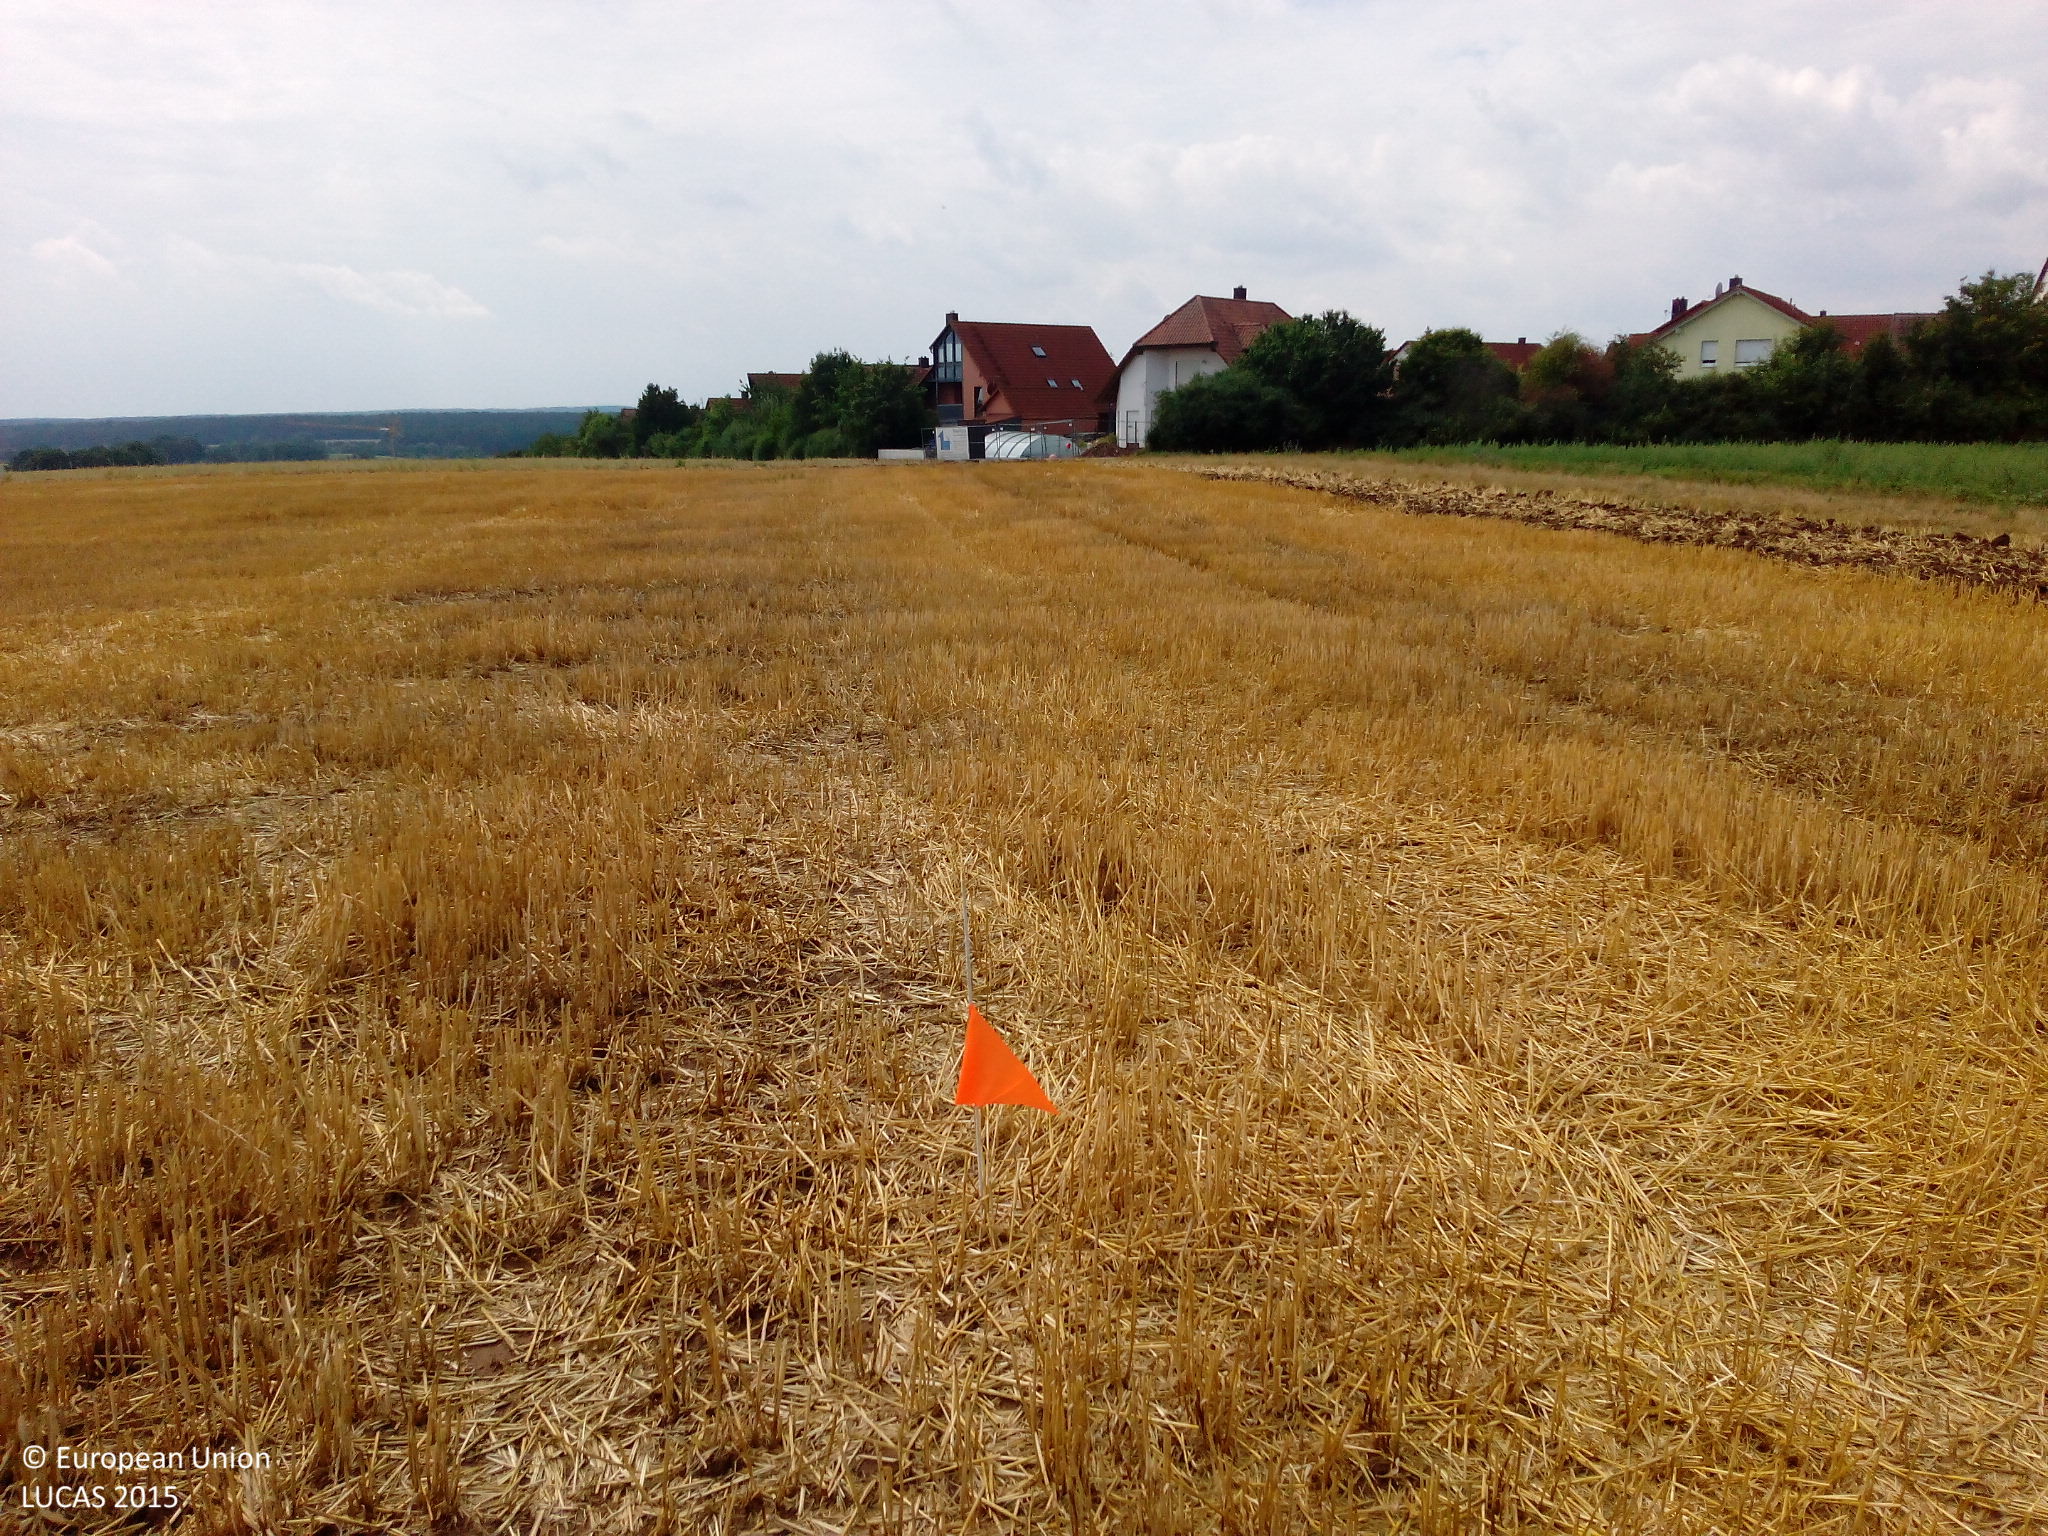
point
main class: Cropland
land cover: Barley
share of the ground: 25 - 50 %
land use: Agriculture (excluding fallow land and kitchen gardens)
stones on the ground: < 10 %
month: July
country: DE
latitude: 49.5153
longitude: 10.8975
